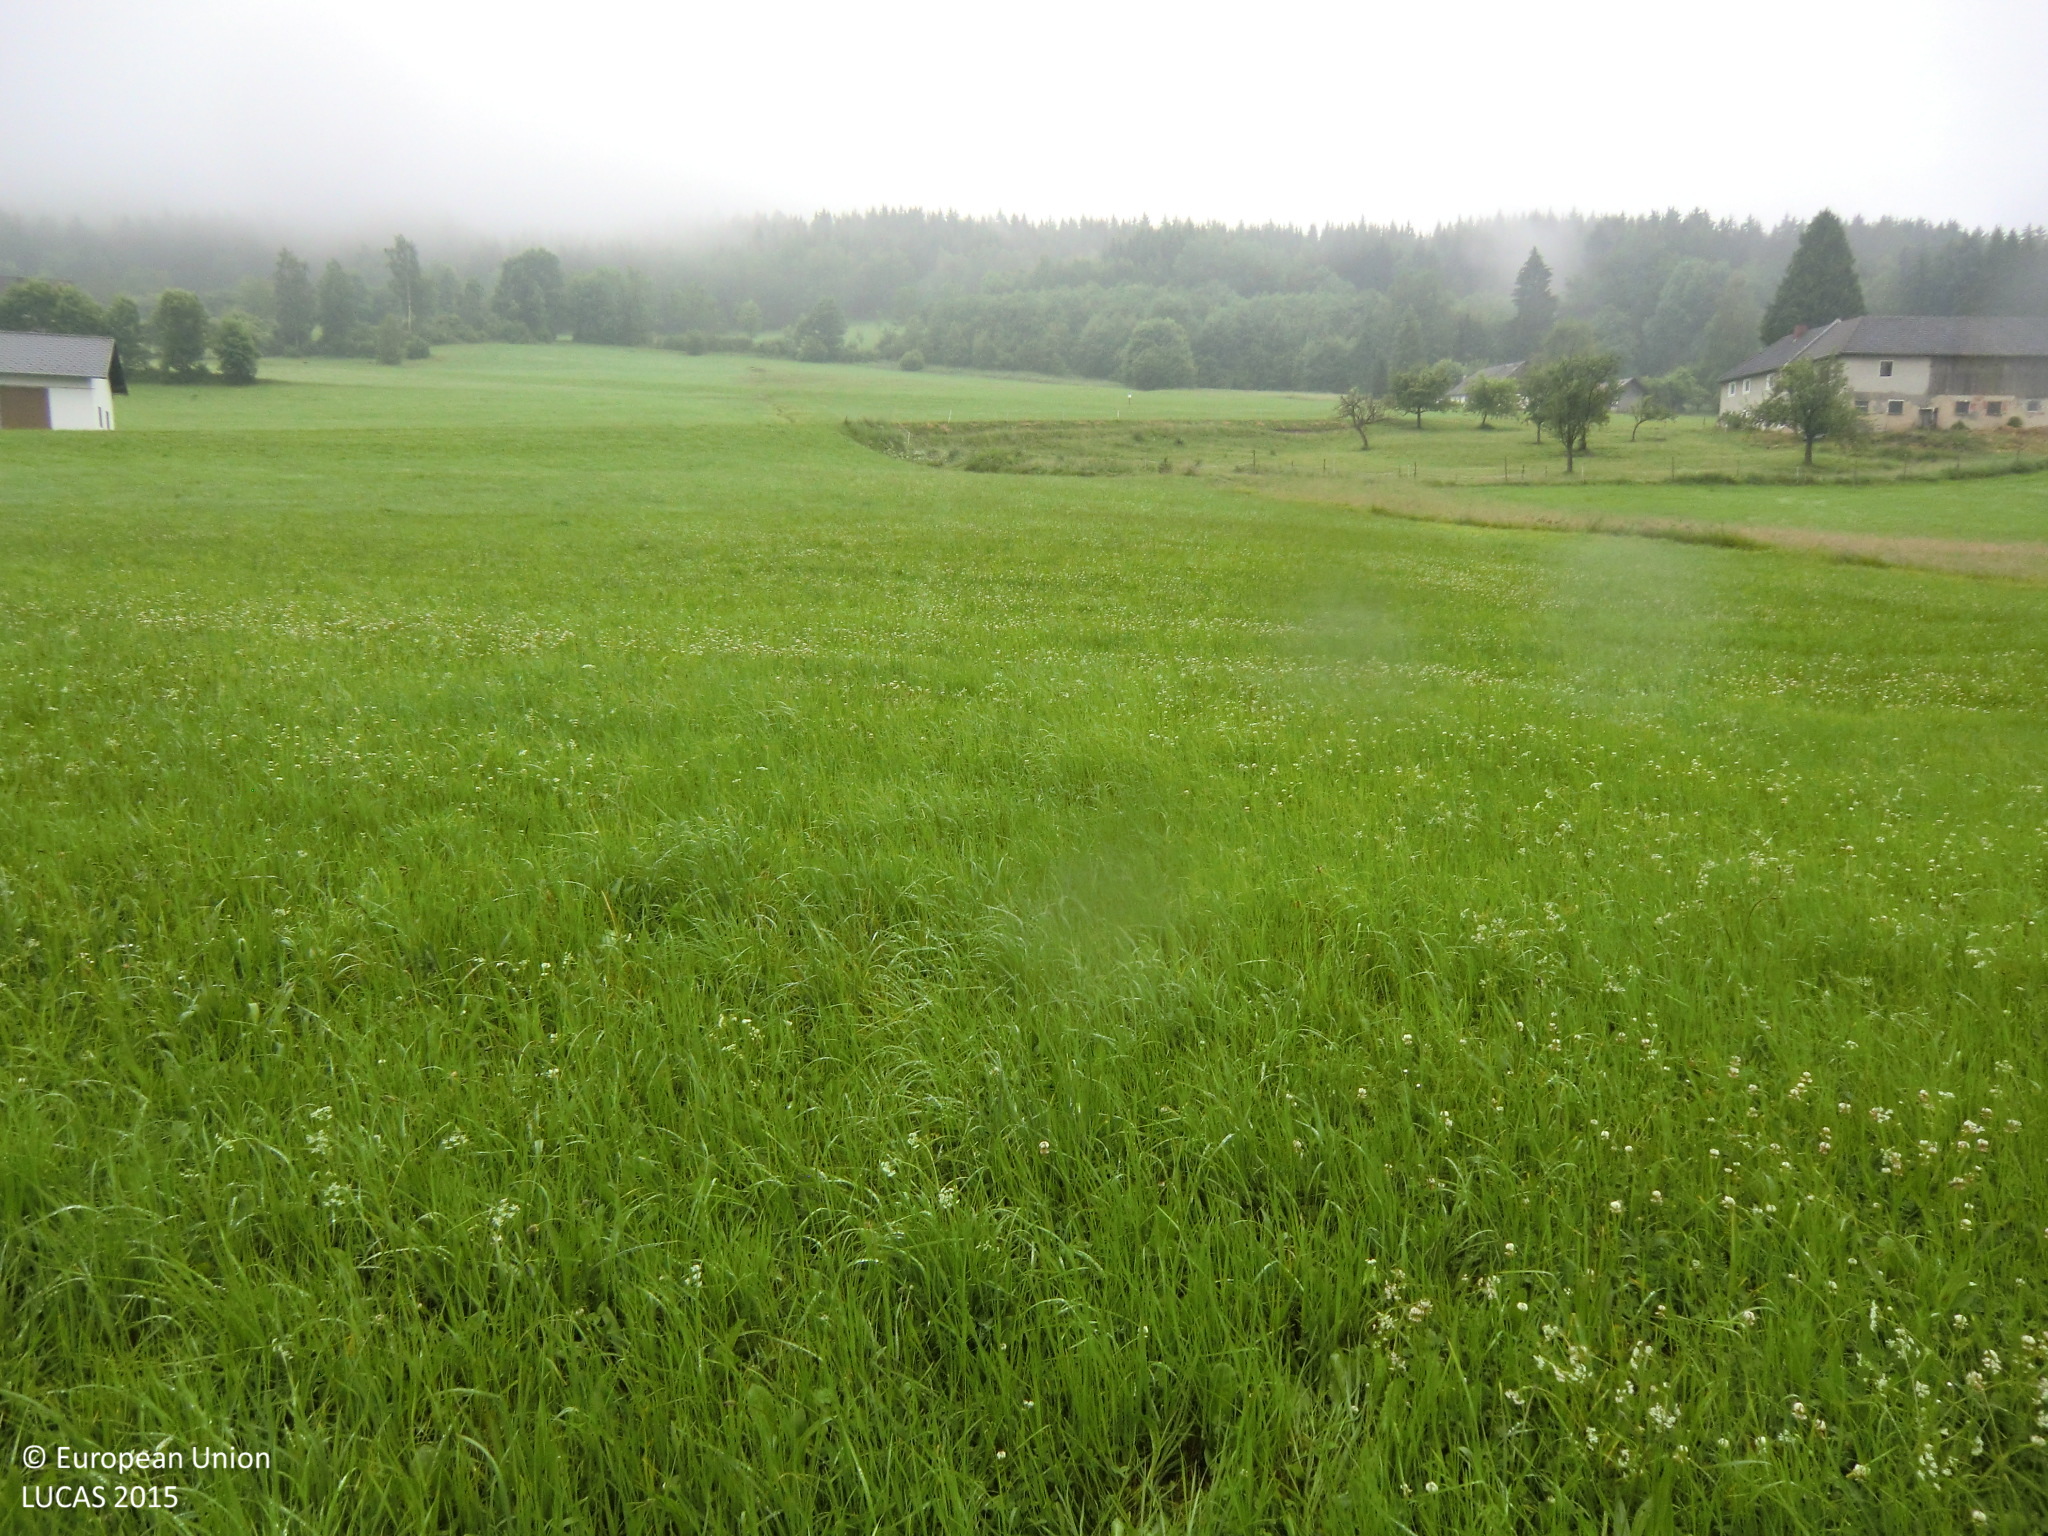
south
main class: Grassland
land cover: Grassland without tree/shrub cover
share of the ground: > 75 %
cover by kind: herbaceous plants 100 %
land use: Agriculture (excluding fallow land and kitchen gardens)
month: June
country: AT
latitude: 48.6142
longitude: 14.5992
